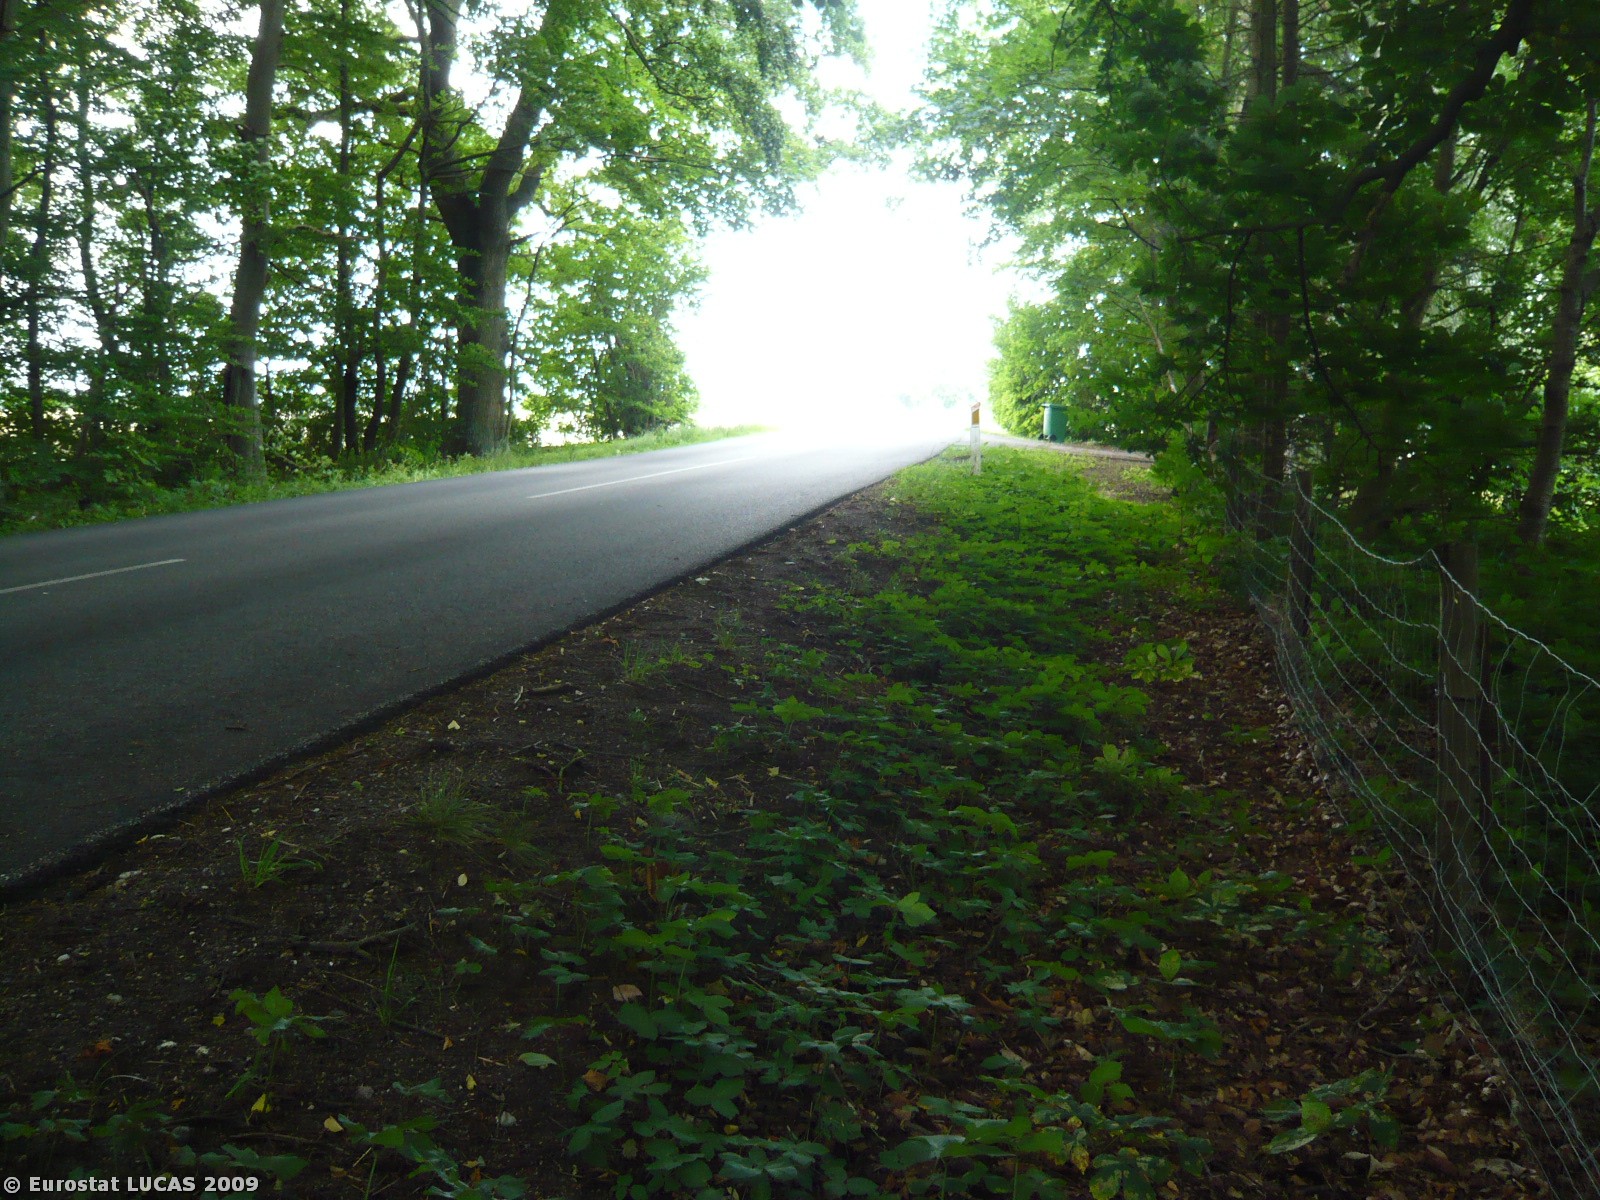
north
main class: Woodland
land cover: Broadleaved woodland
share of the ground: > 75 %
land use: Residential
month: July
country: DK
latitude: 55.4359
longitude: 11.9424
